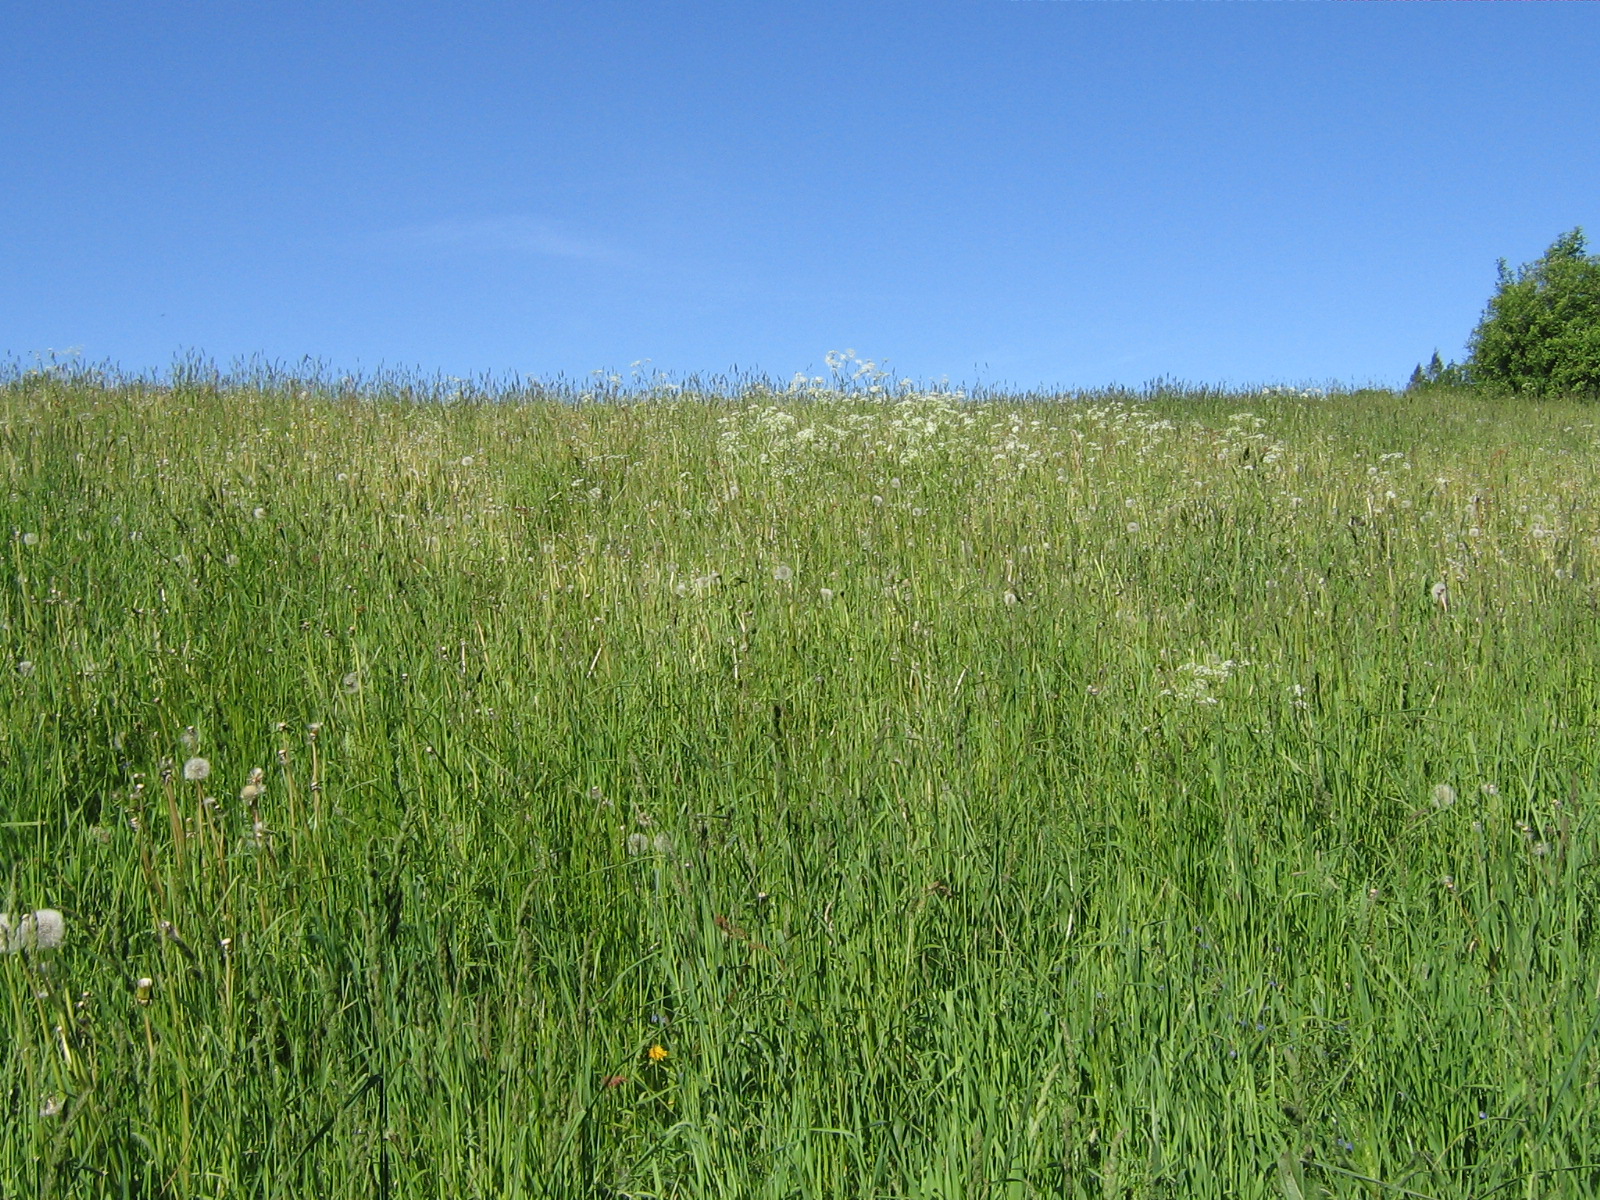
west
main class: Grassland
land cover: Grassland without tree/shrub cover
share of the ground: > 75 %
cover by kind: herbaceous plants 100 %
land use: Agriculture (excluding fallow land and kitchen gardens)
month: June
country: LV
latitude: 57.0642
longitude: 25.8764
